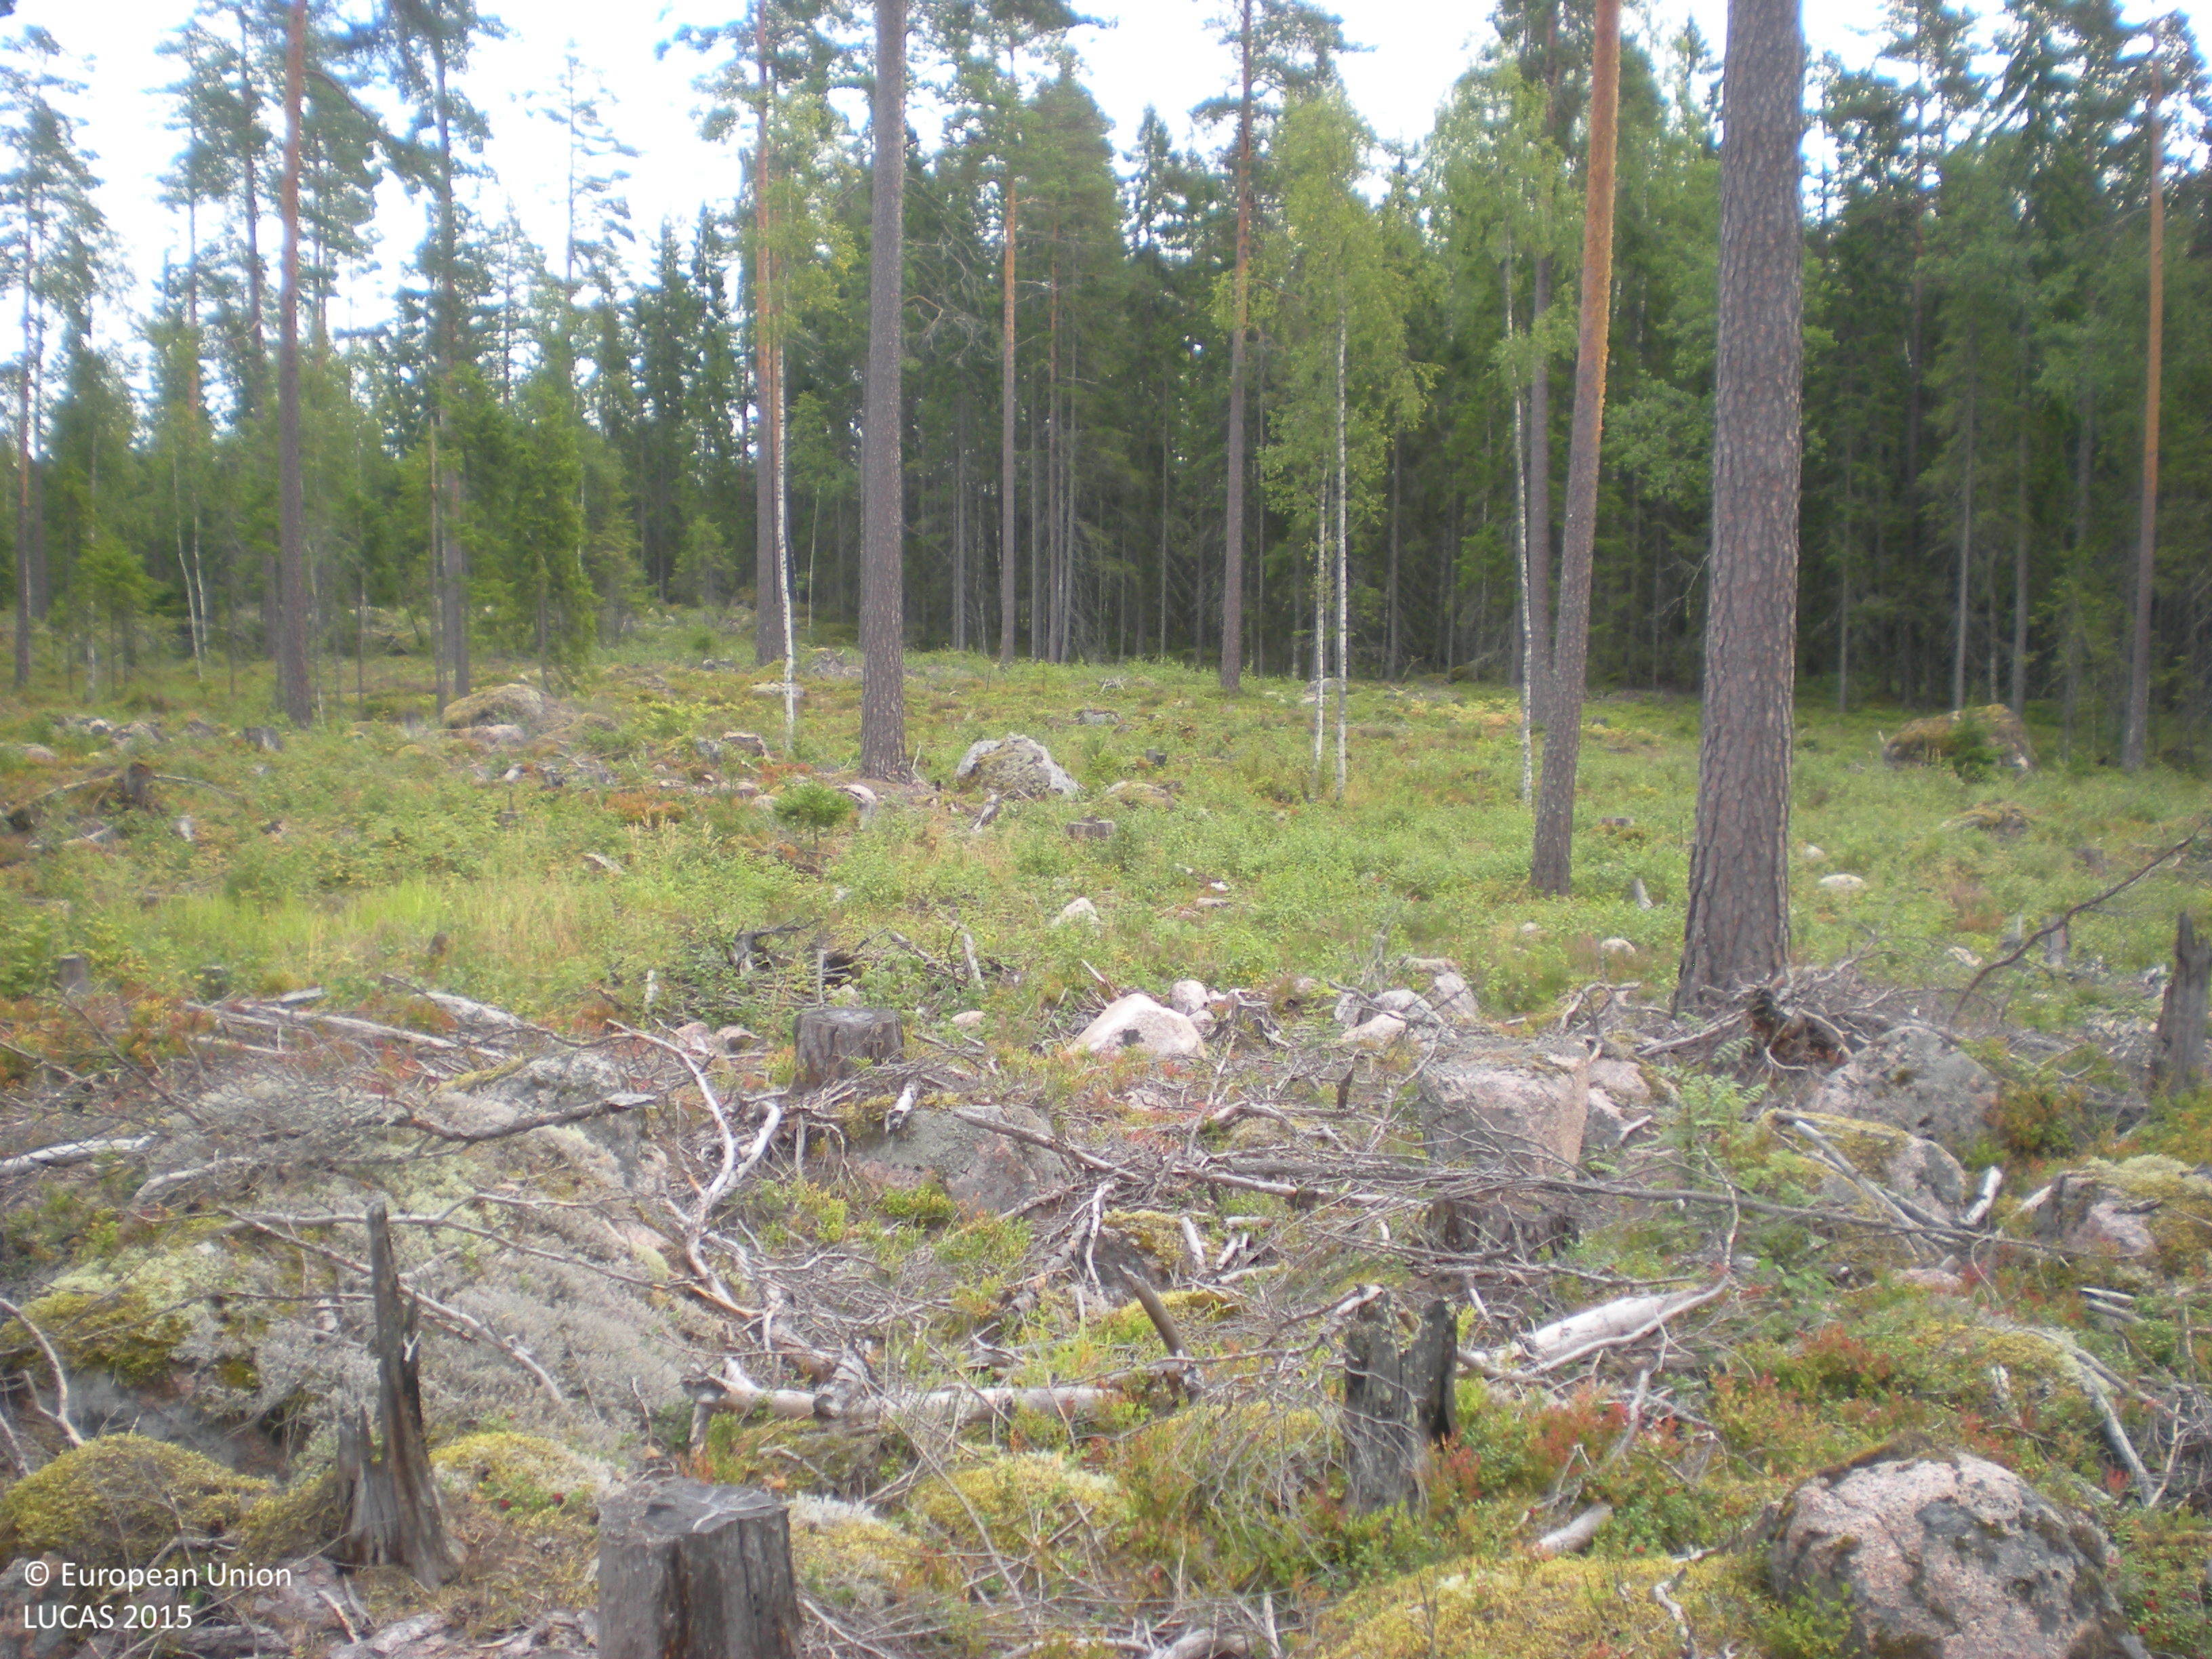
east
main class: Woodland
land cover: Pine dominated coniferous woodland
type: boreal forest
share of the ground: 25 - 50 %
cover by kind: coniferous forest trees 40 %, shrubs 25 %, consolidated bare surface 20 %, lichens and mosses 10 %, broadleaved forest trees 5 %
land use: Forestry
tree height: > 5 m
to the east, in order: Pine dominated coniferous woodland; Spruce dominated coniferous woodland; Shrubland without tree cover; Other coniferous woodland; Rivers and streams; Other coniferous woodland; Pine dominated coniferous woodland
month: August
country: SE
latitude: 60.4323
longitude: 16.8022
